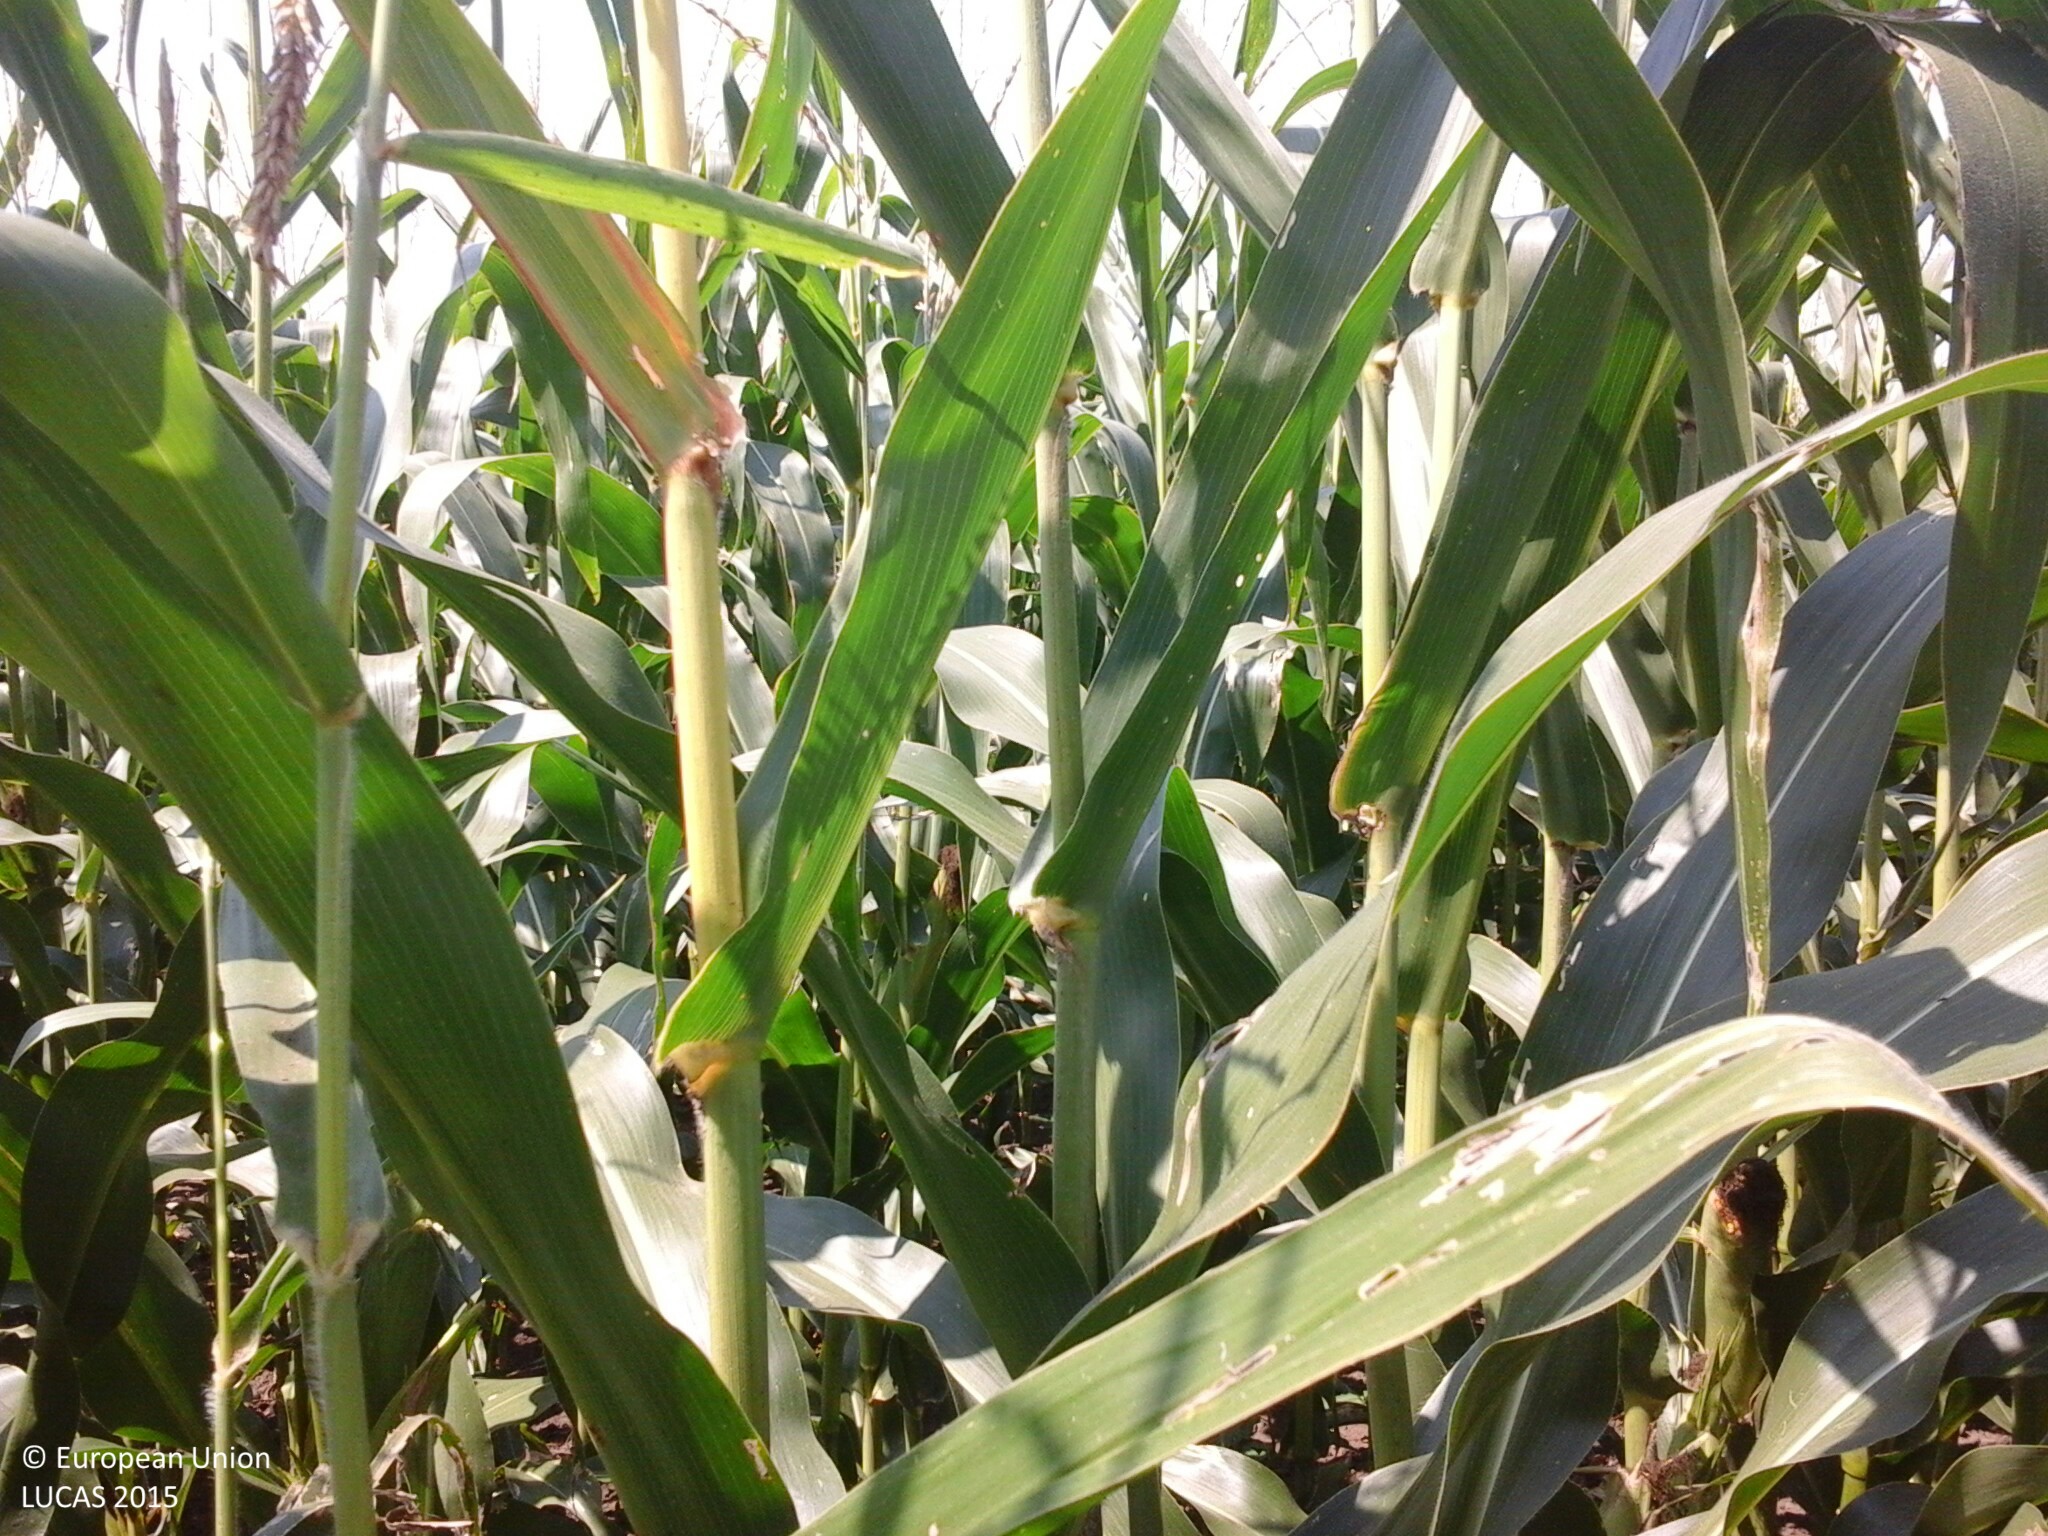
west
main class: Cropland
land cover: Maize
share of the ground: > 75 %
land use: Agriculture (excluding fallow land and kitchen gardens)
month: August
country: HU
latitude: 46.9114
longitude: 18.3481
